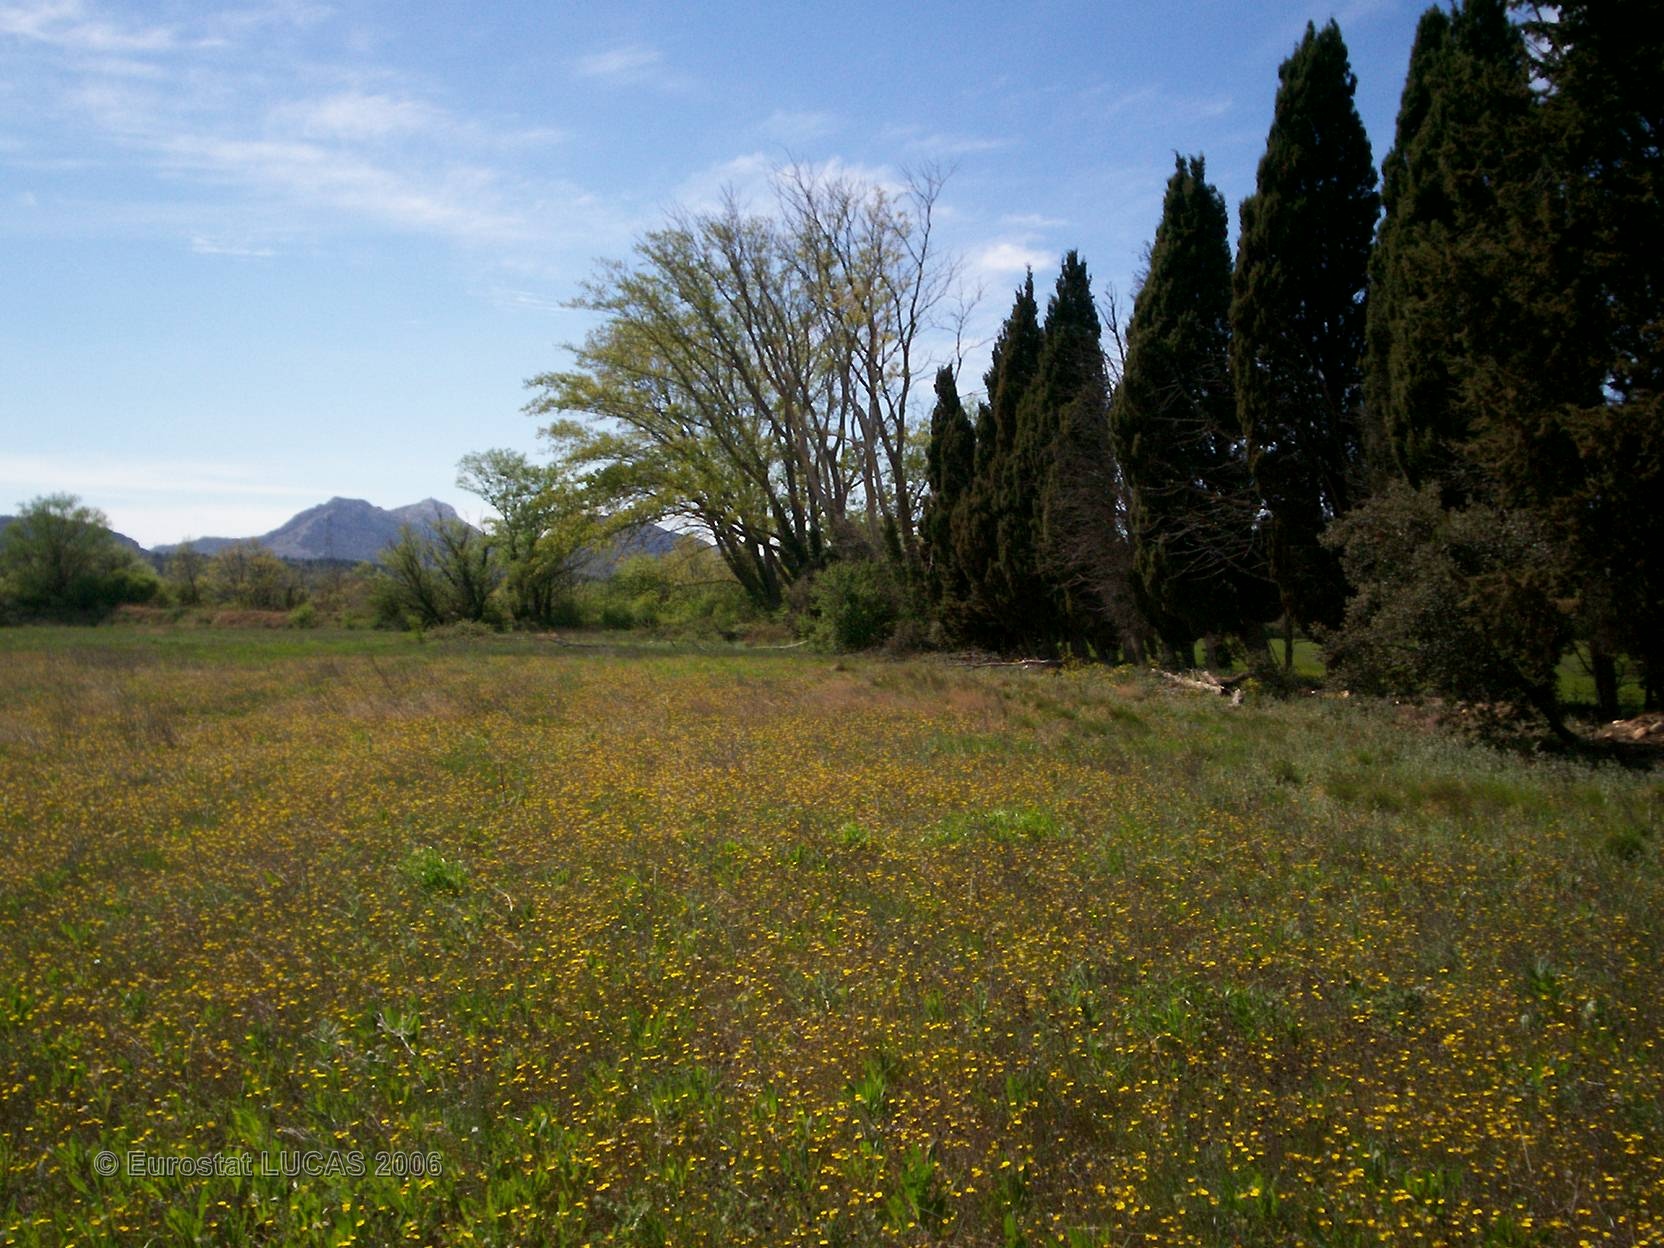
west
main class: Grassland
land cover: Grassland without tree/shrub cover
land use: Agriculture (excluding fallow land and kitchen gardens)
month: April
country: FR
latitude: 43.7268
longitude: 5.0560
